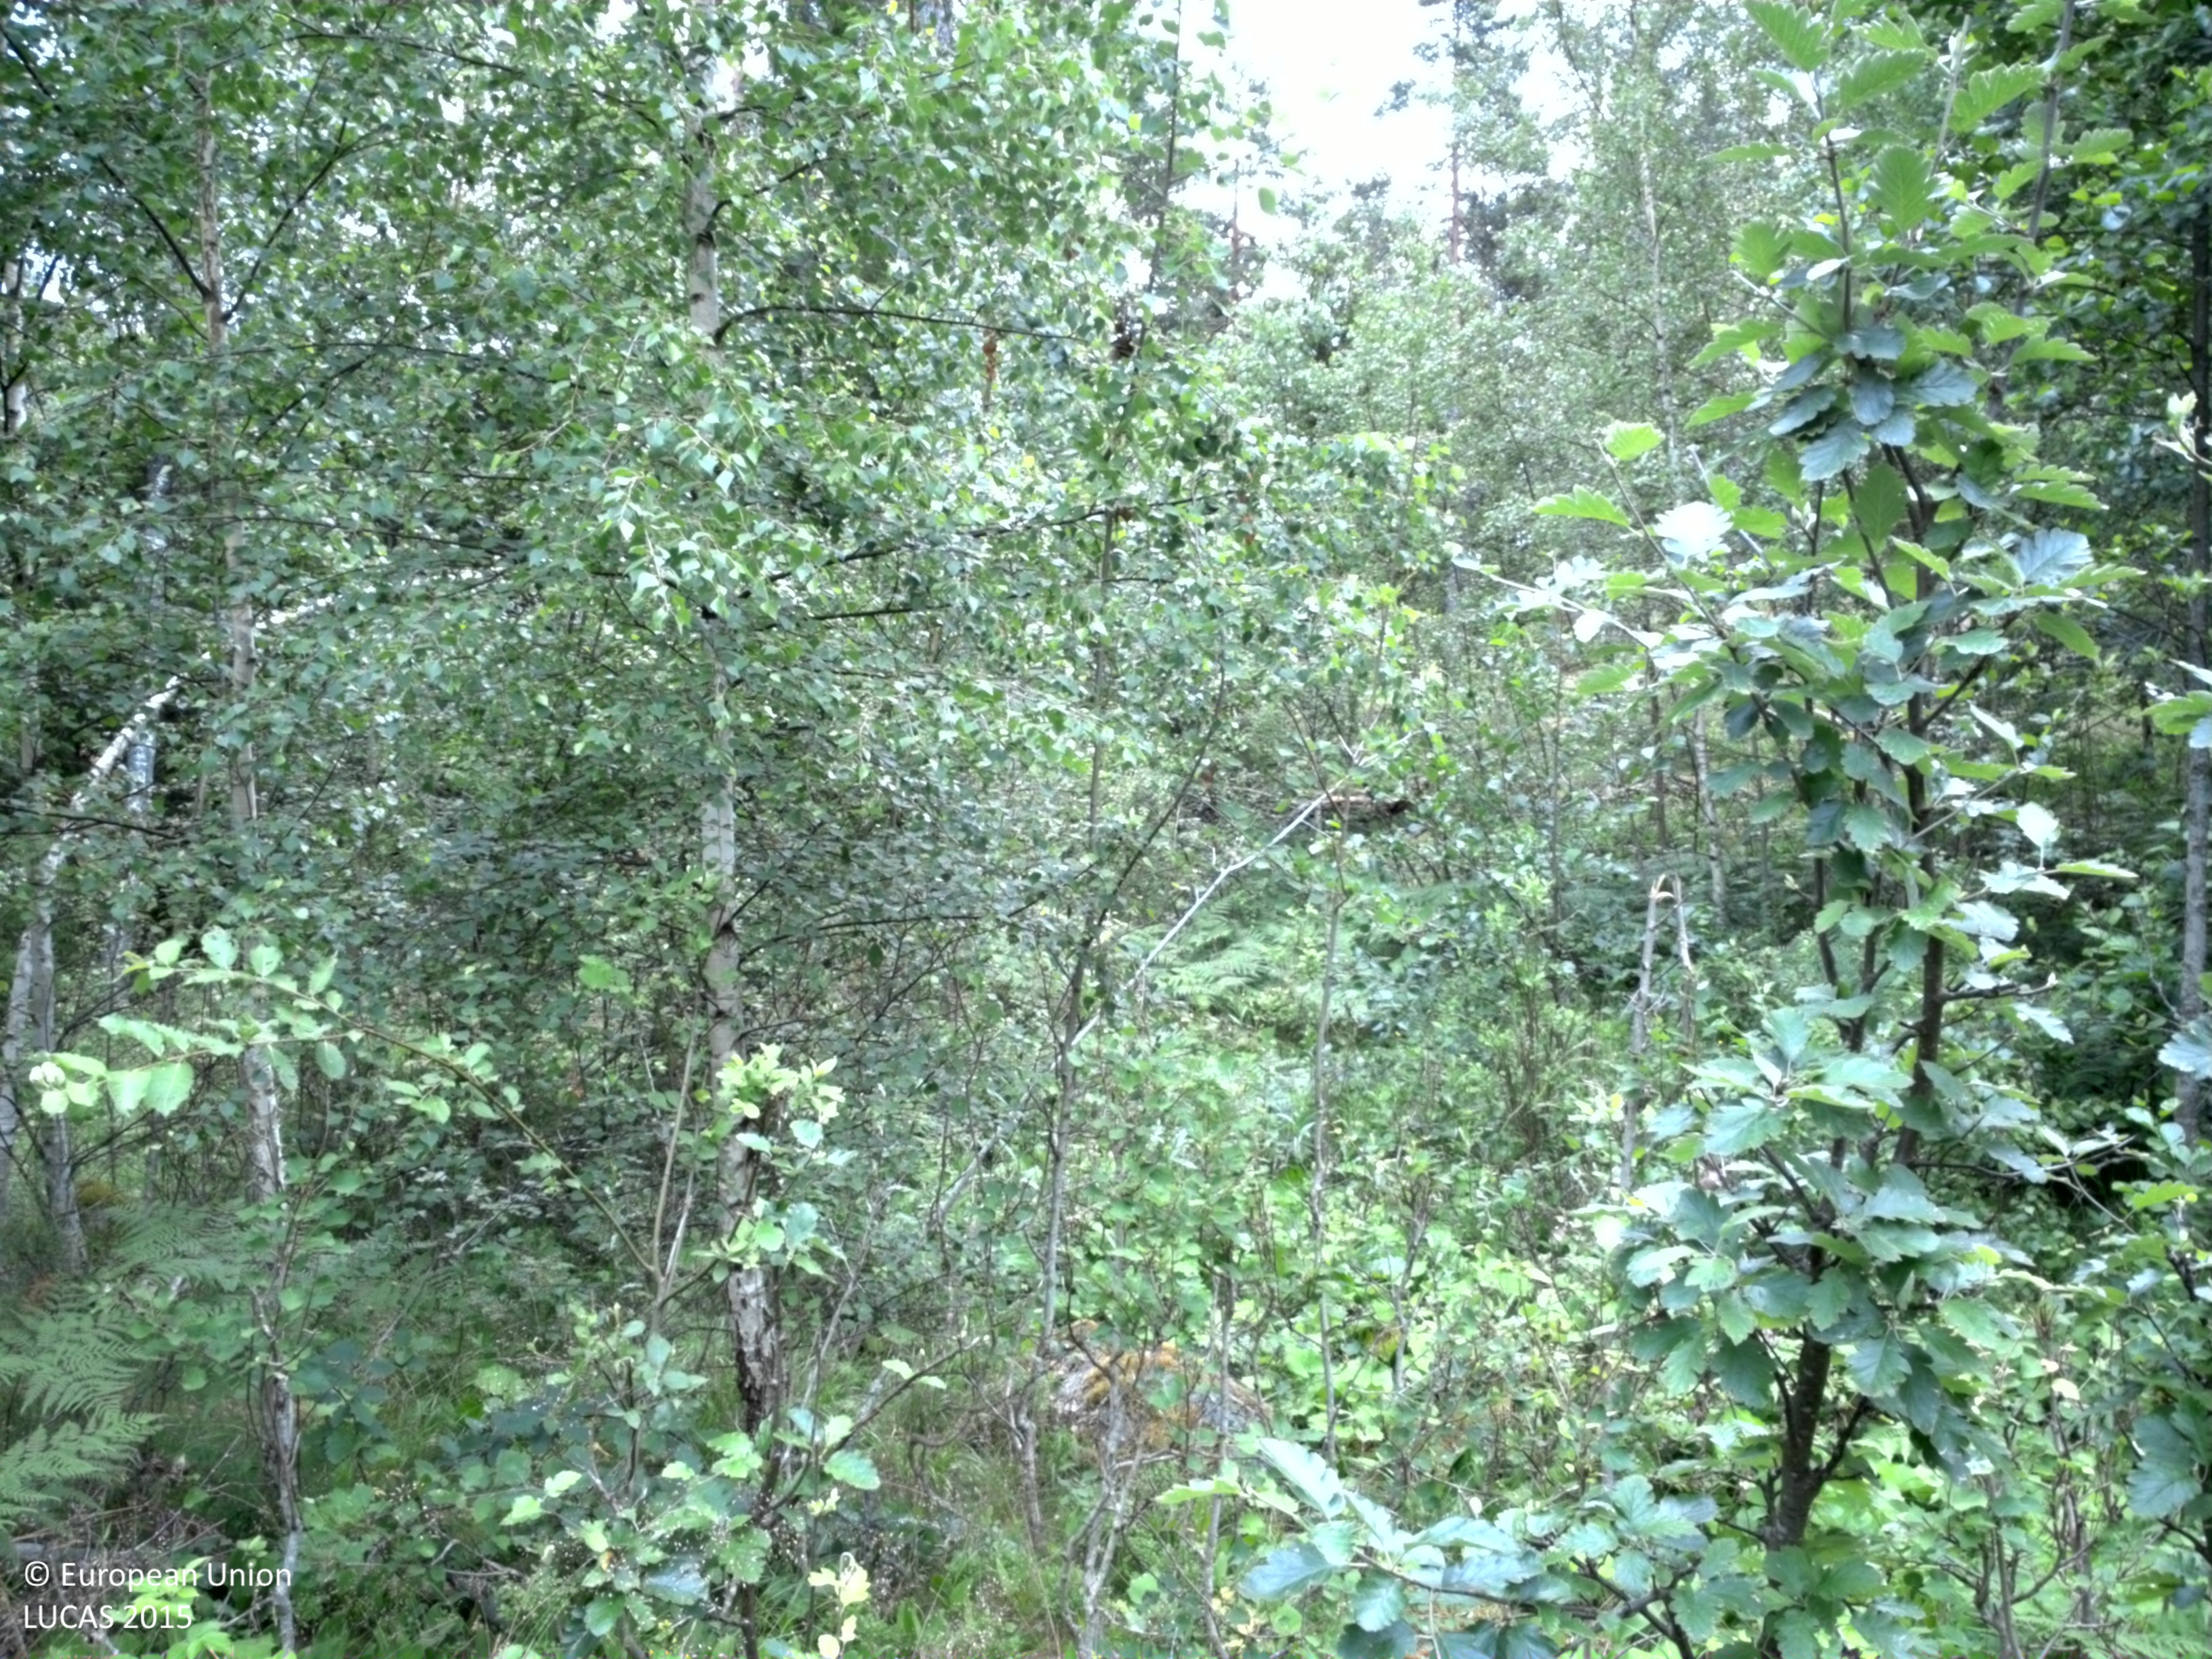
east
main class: Woodland
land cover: Broadleaved woodland
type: hemiboreal forest and nemoral coniferous forest and mixed broadleaved-coniferous forest
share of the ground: 25 - 50 %
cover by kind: herbaceous plants 50 %, broadleaved forest trees 45 %, coniferous forest trees 5 %
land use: Forestry
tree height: > 5 m
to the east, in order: Broadleaved woodland; Spruce dominated mixed woodland; Ditches and canals; Other leguminous and mixtures for fodder; Ditches and canals; Spruce dominated mixed woodland; Spruce dominated coniferous woodland; Spruce dominated mixed woodland; Ditches and canals; Other leguminous and mixtures for fodder
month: July
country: SE
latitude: 59.7728
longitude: 18.6007
